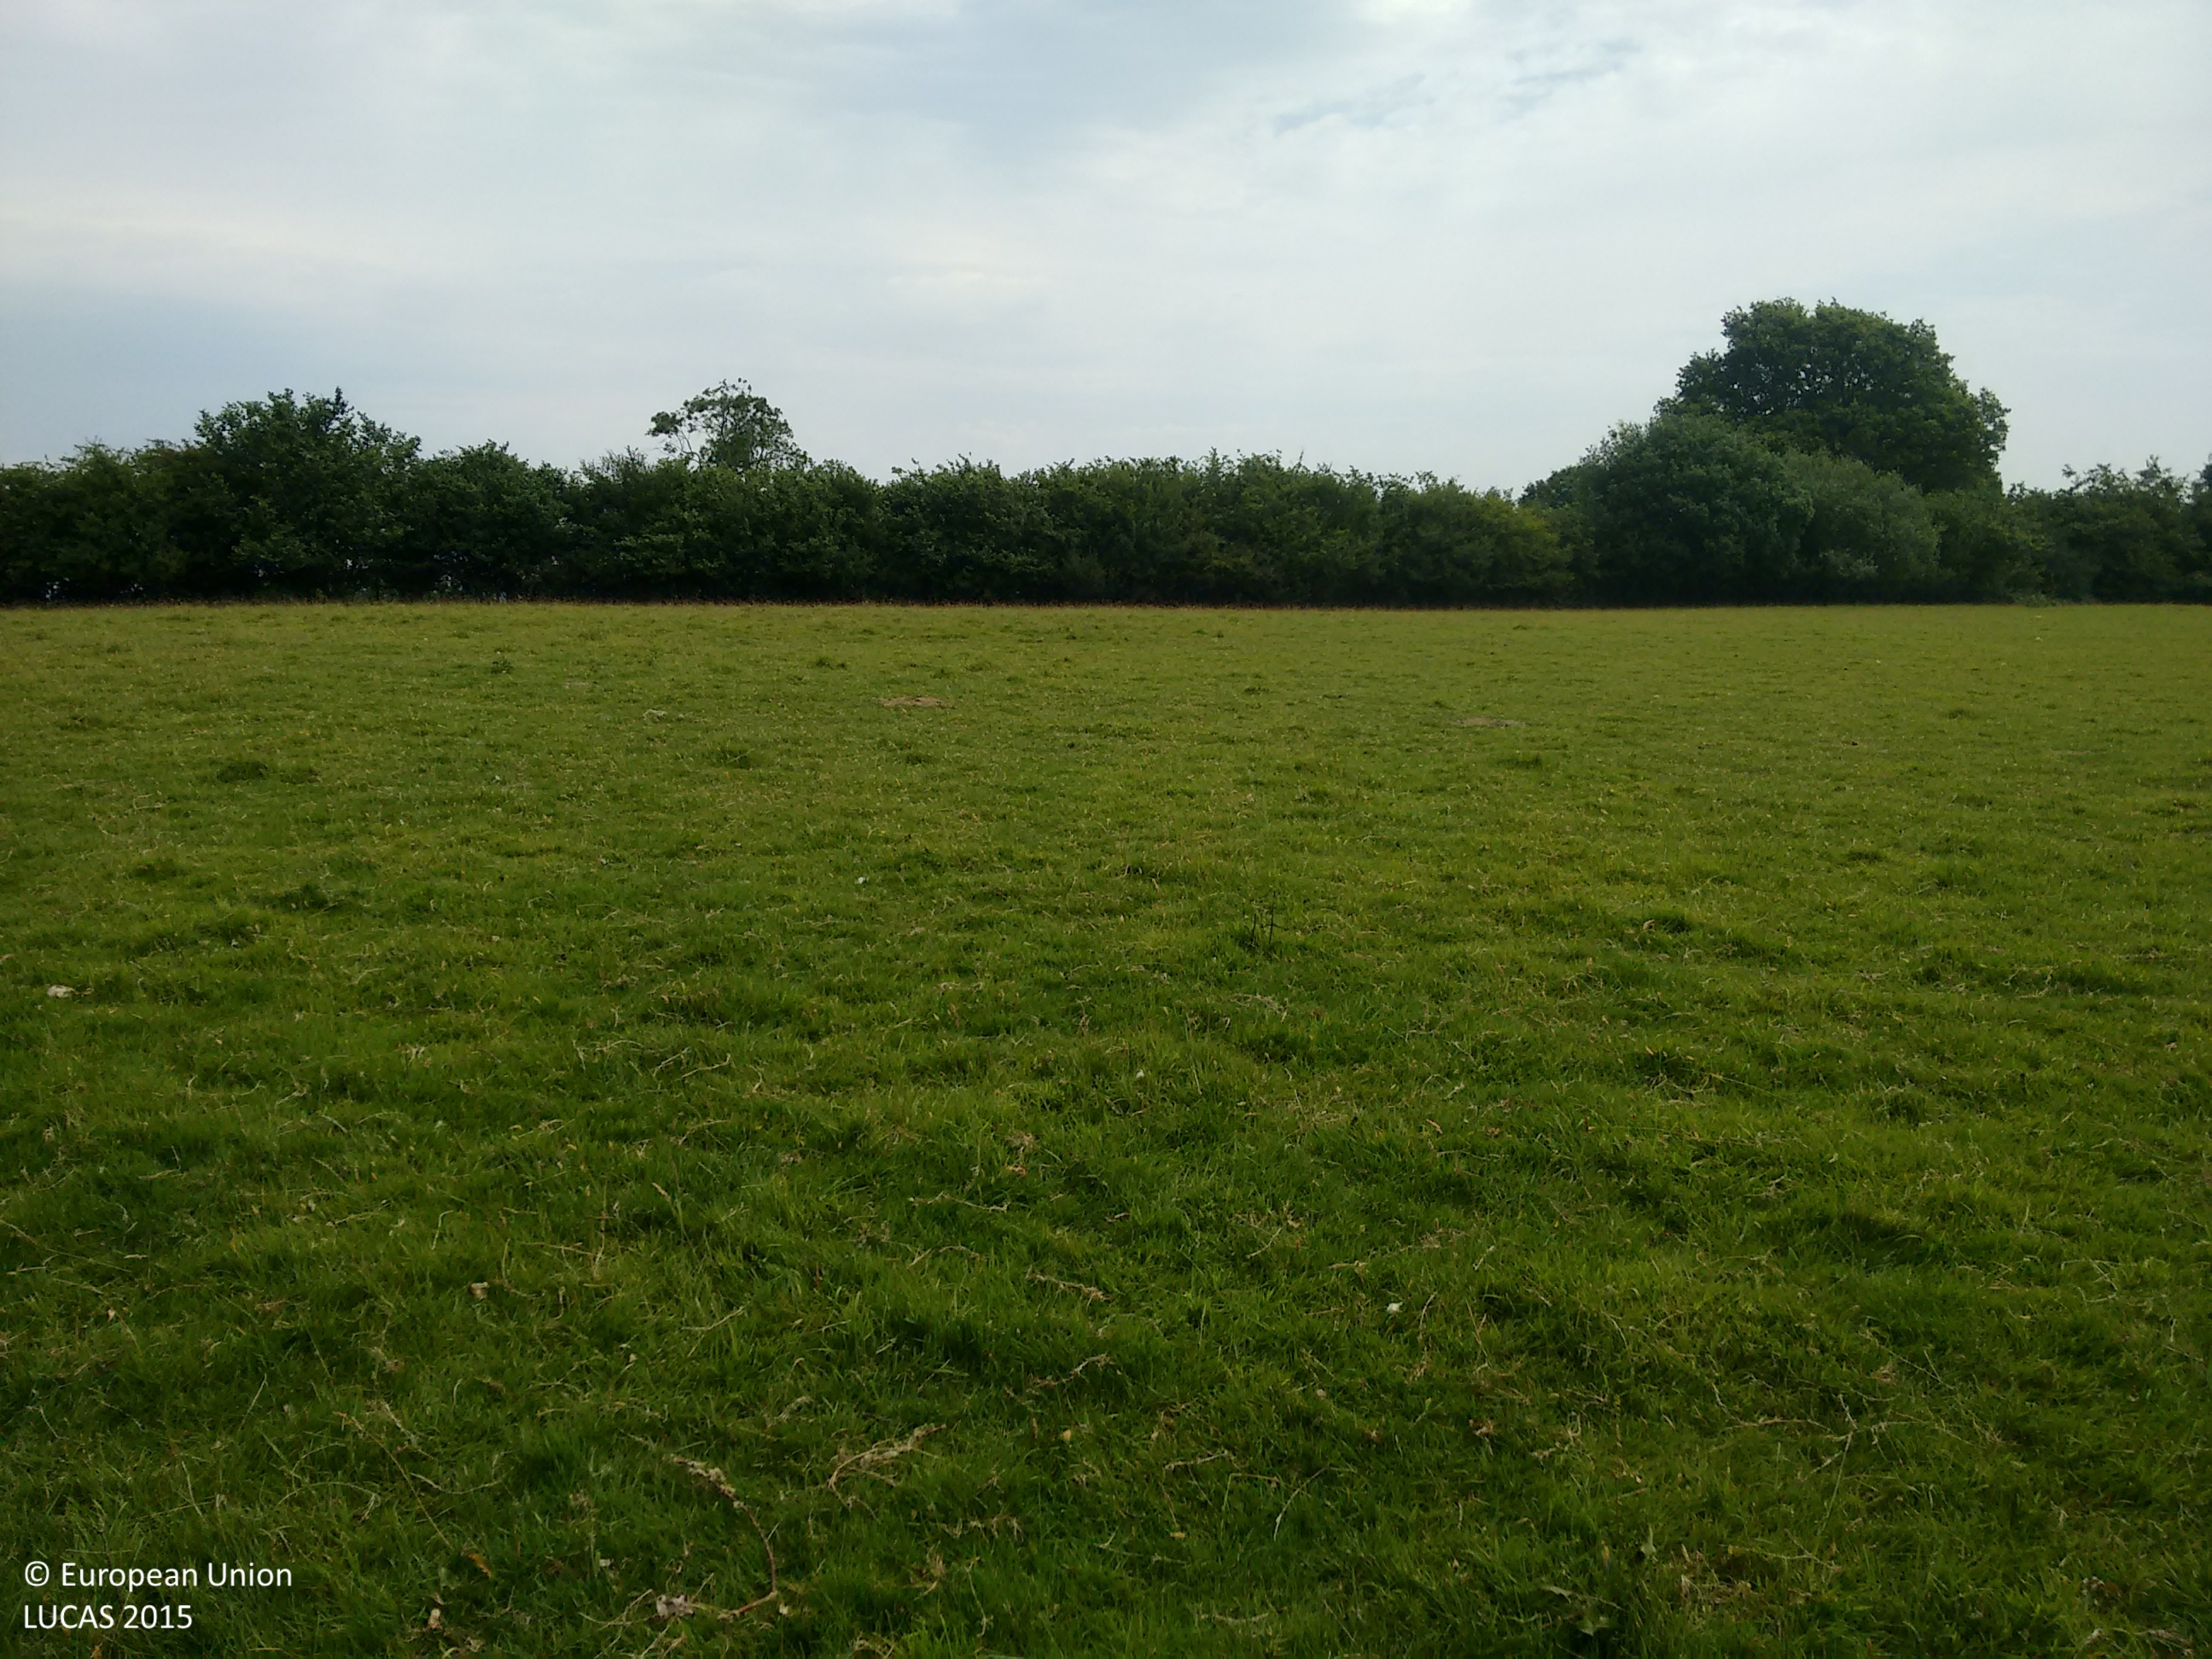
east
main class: Grassland
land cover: Grassland without tree/shrub cover
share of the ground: > 75 %
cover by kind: herbaceous plants 100 %
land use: Agriculture (excluding fallow land and kitchen gardens)
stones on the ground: < 10 %
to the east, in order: Grassland without tree/shrub cover; Managed hedges; Fences; Grassland without tree/shrub cover; Tracks; Grassland without tree/shrub cover; Tracks; Grassland without tree/shrub cover; Tracks; Fences; Managed hedges; Spontaneously vegetated surfaces
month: July
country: GB
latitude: 50.9694
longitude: -0.0730
